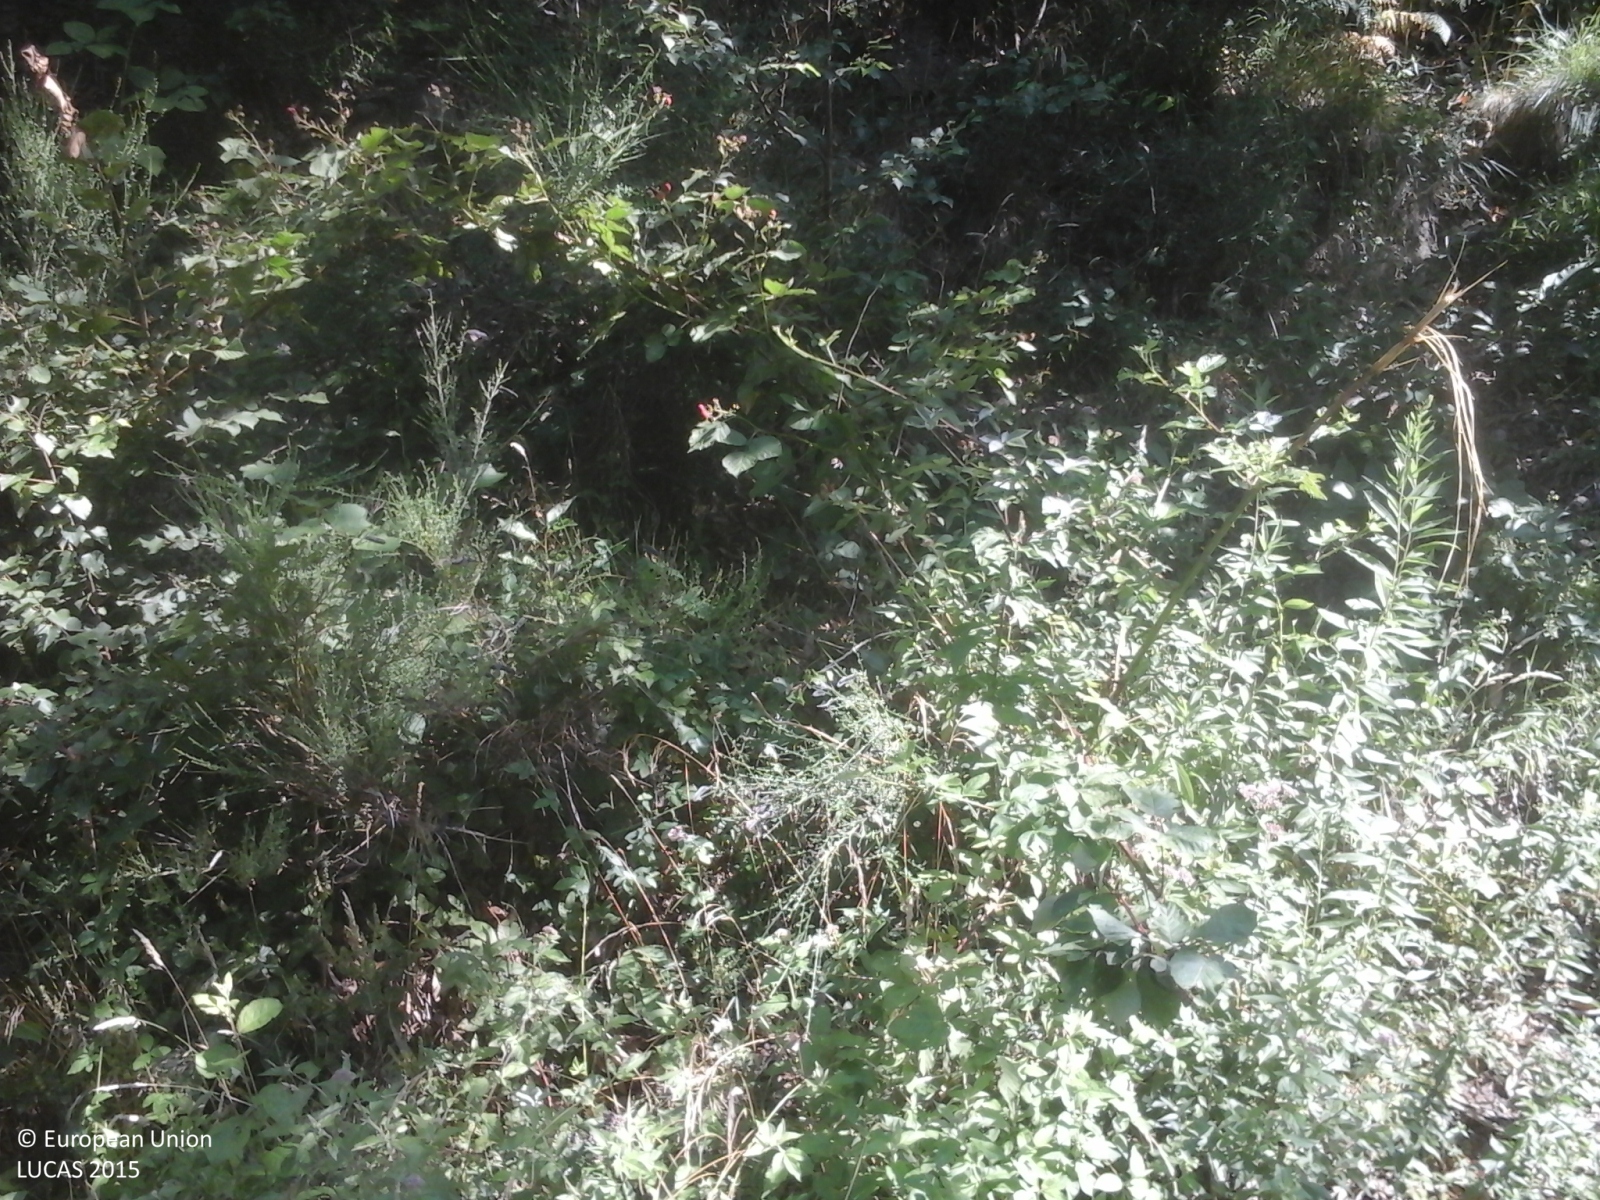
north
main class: Woodland
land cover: Broadleaved woodland
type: thermophilous deciduous forest
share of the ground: > 75 %
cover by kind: broadleaved forest trees 100 %
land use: Forestry
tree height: > 5 m
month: August
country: IT
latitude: 46.1698
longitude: 9.4697
